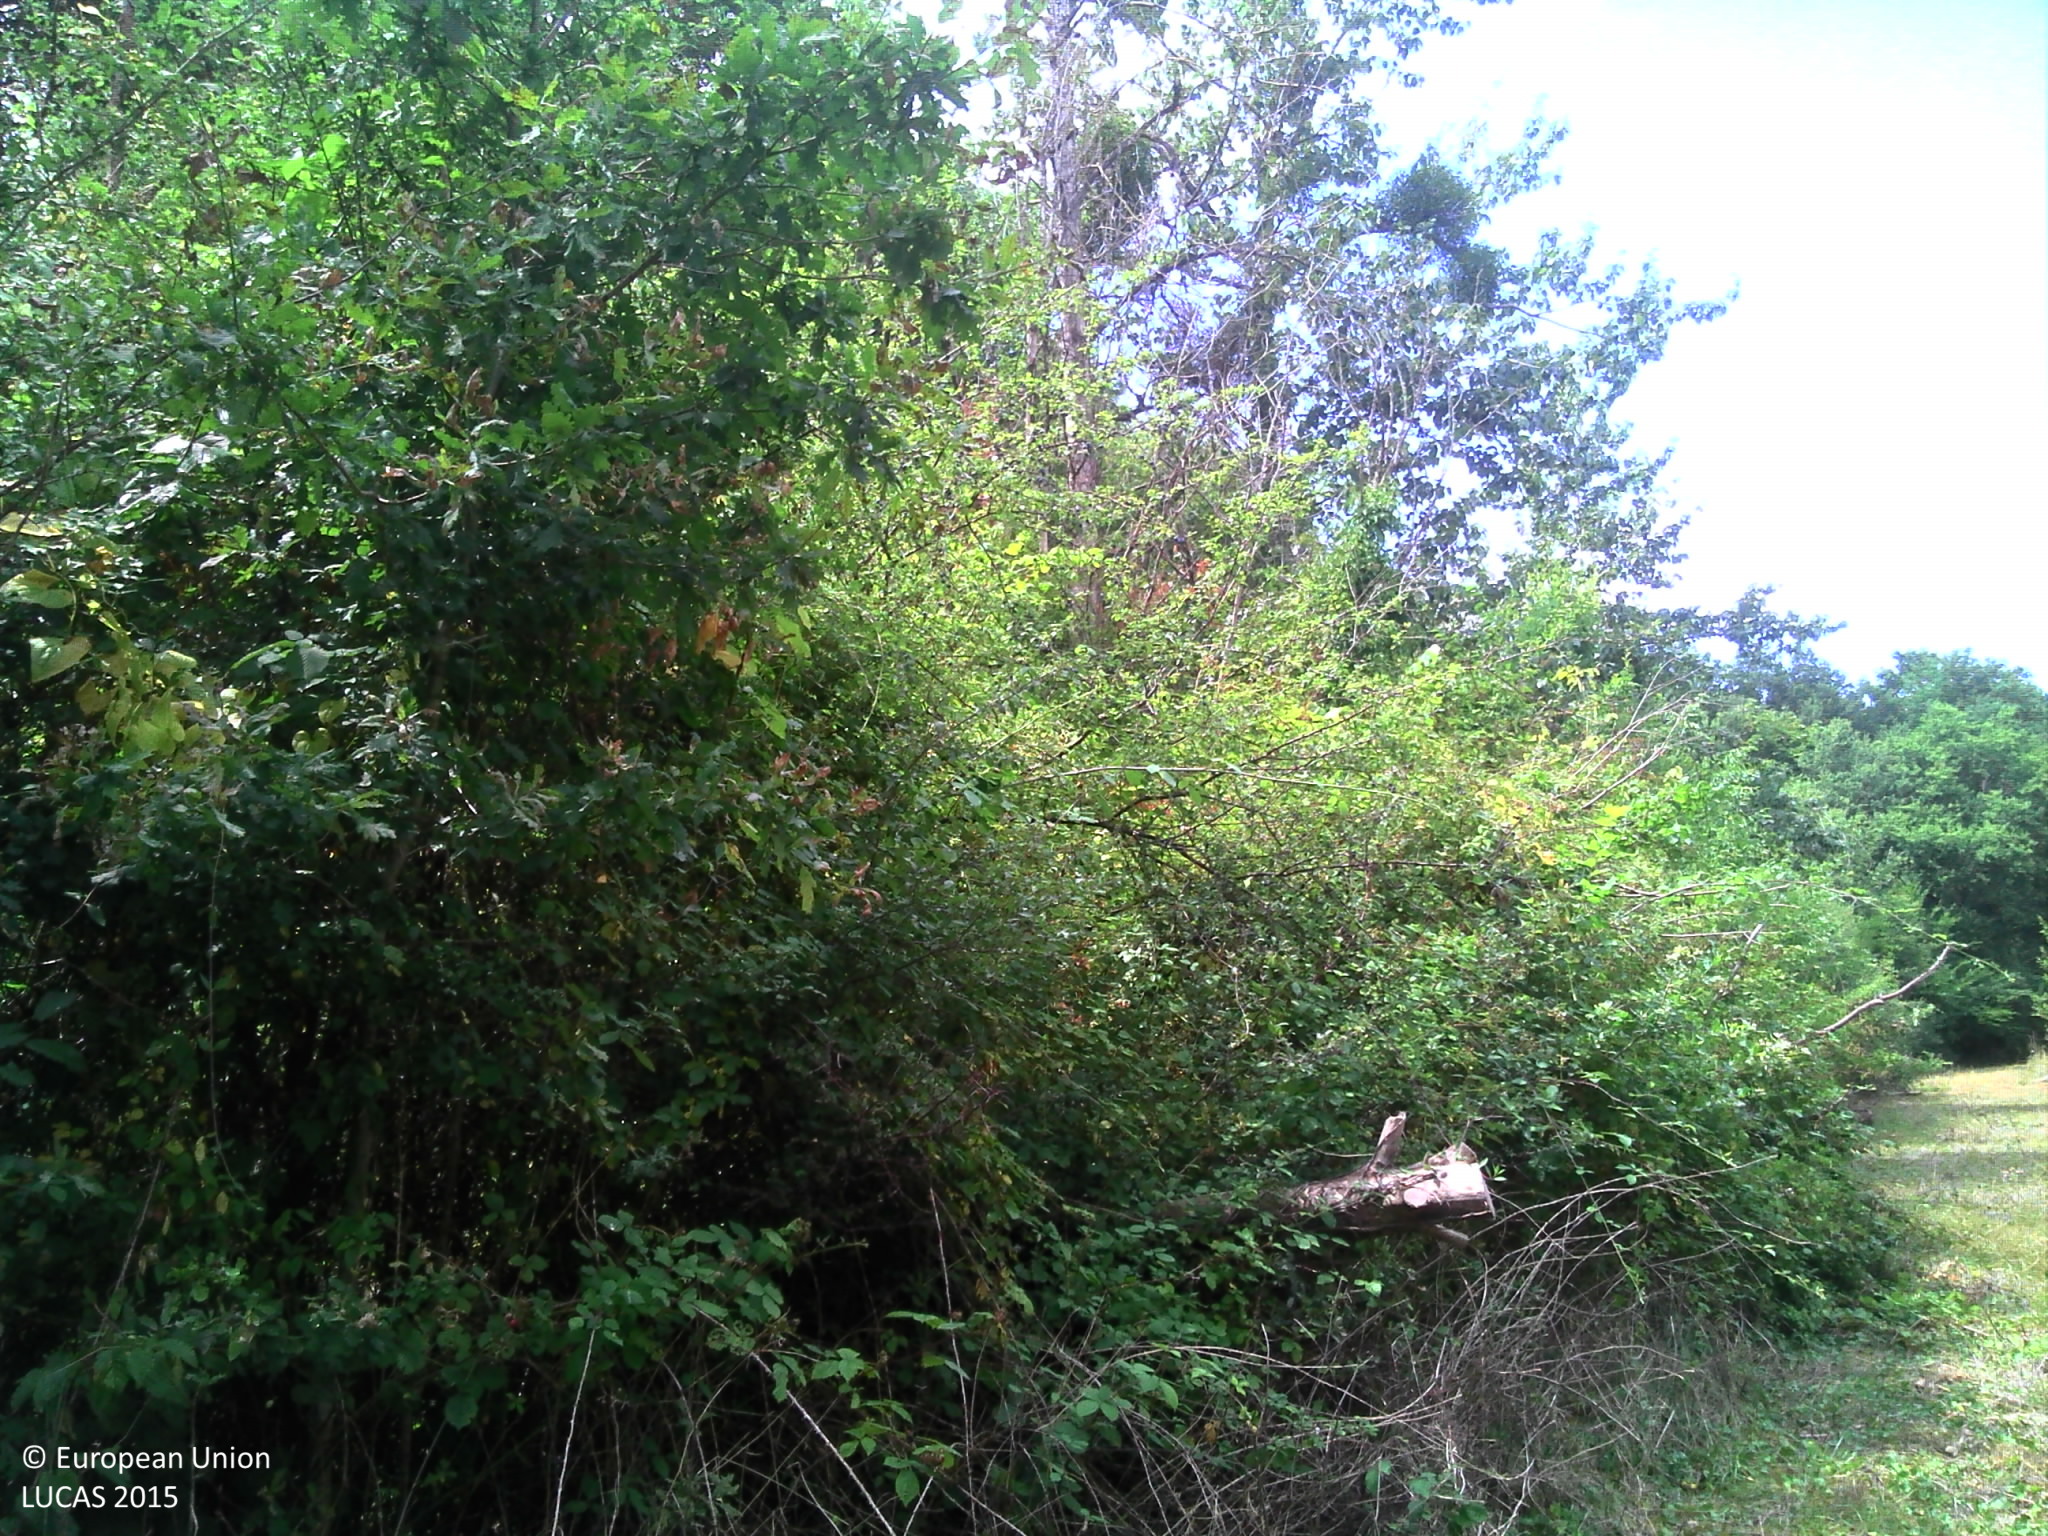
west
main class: Woodland
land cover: Broadleaved woodland
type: mesophytic deciduous forest
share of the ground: > 75 %
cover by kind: broadleaved forest trees 65 %, coniferous forest trees 10 %, shrubs 10 %, herbaceous plants 10 %, lichens and mosses 5 %
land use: Forestry
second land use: Amenities, museums, leisure
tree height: > 5 m
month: July
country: FR
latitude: 47.1111
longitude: 0.7705
